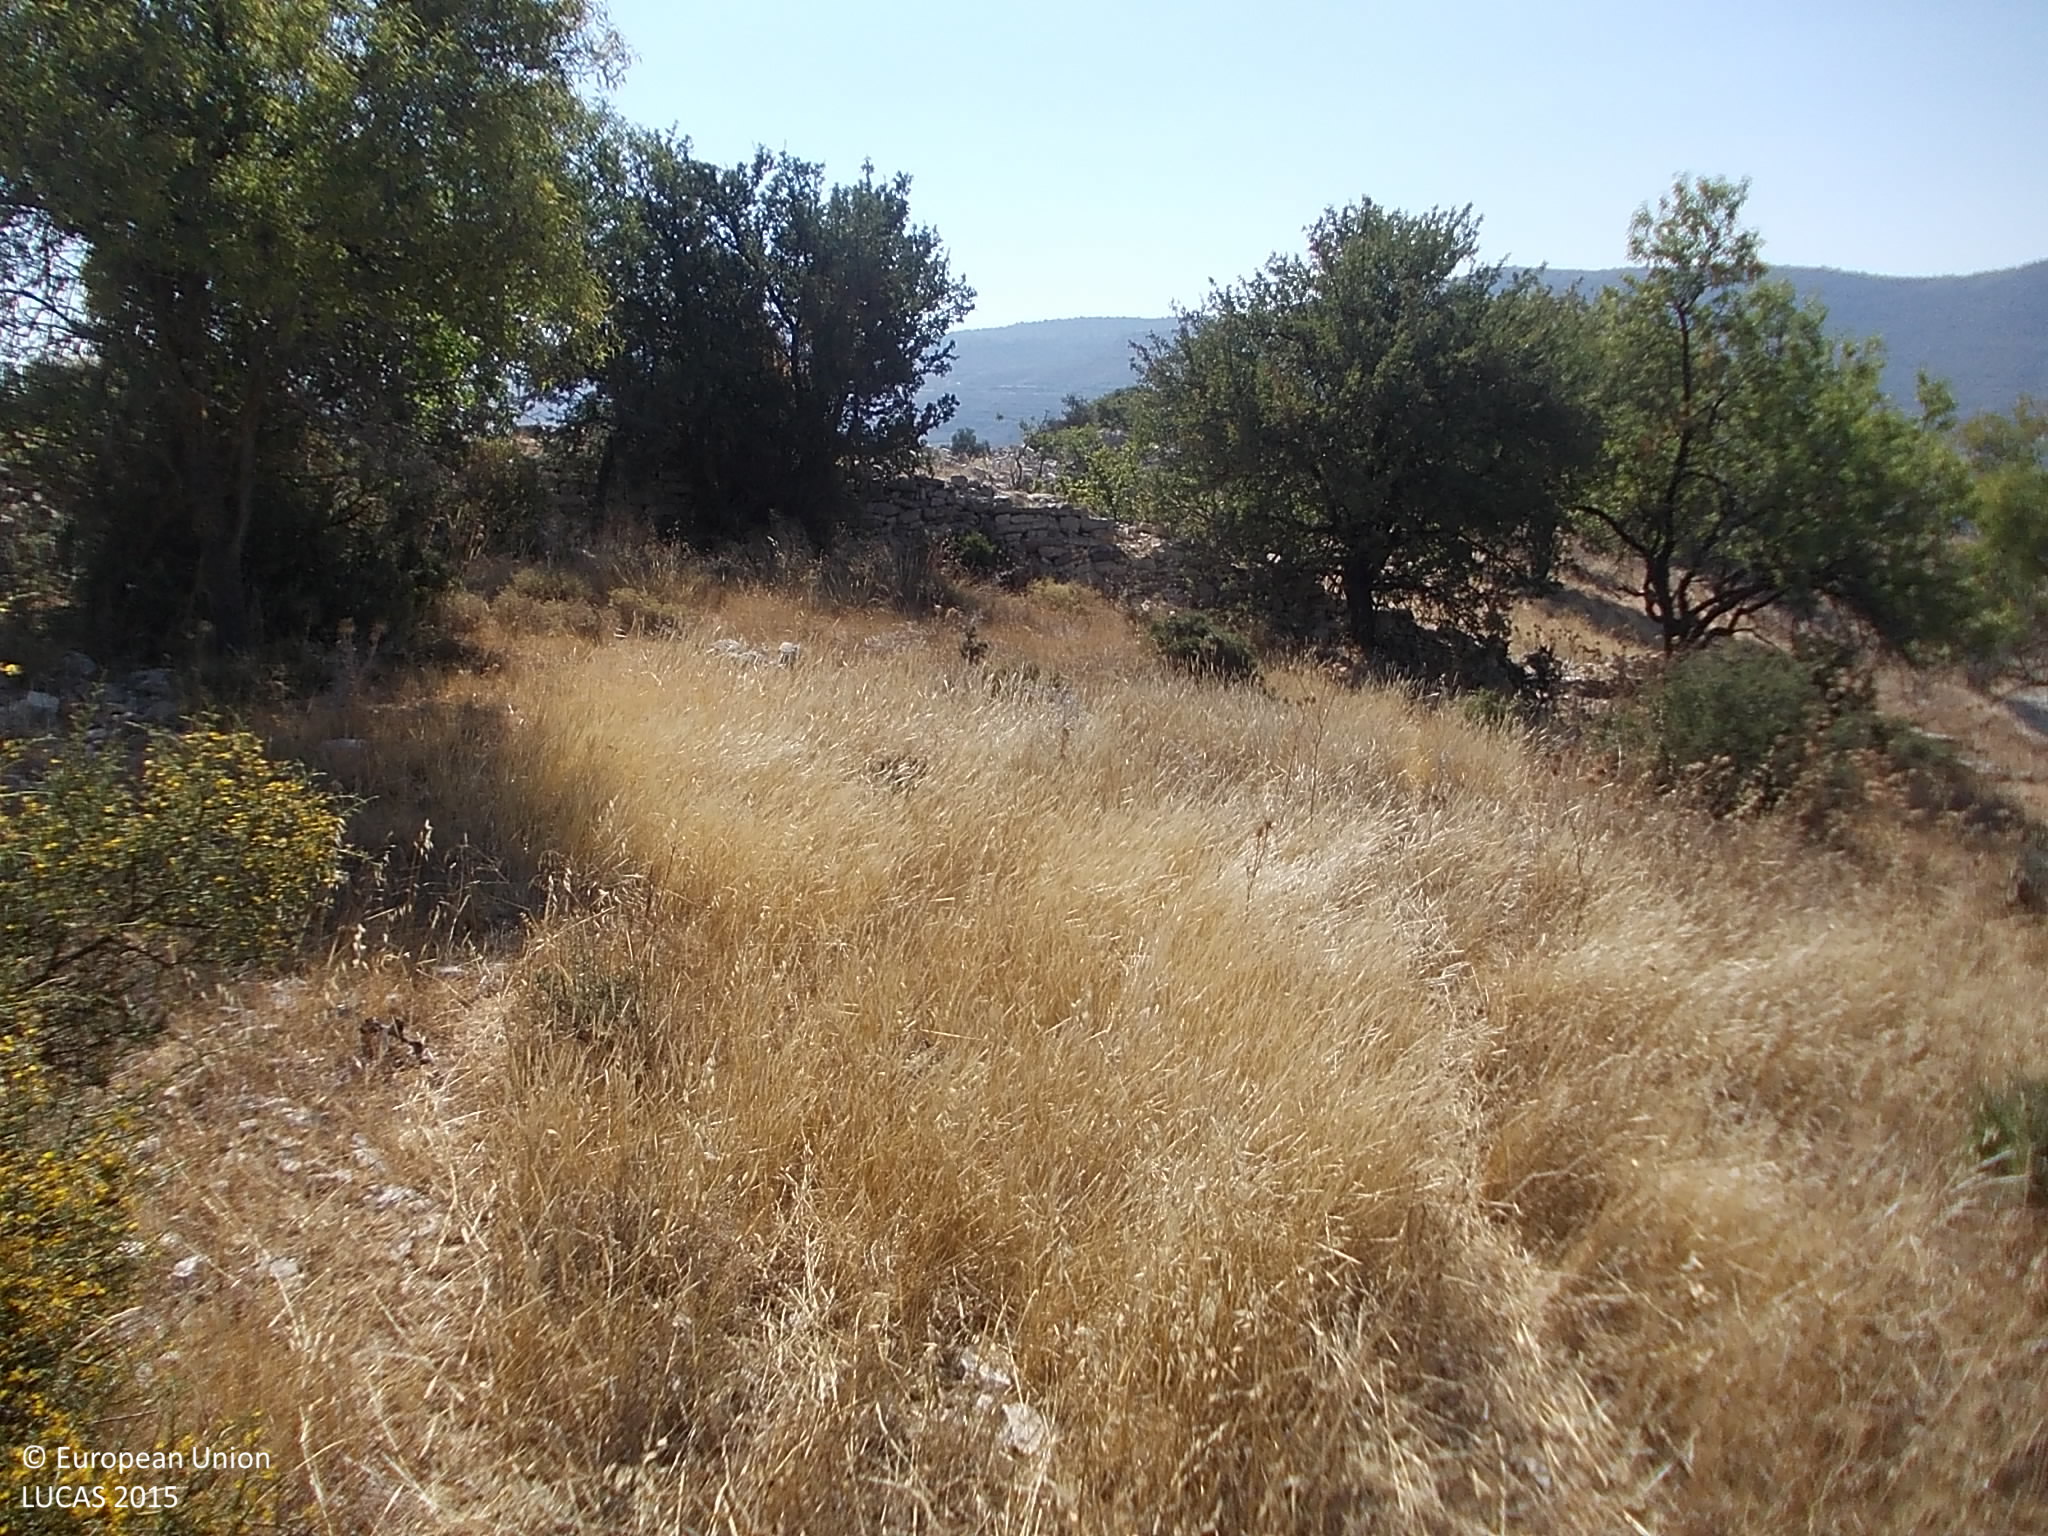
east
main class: Cropland
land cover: Nuts trees
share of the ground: 10 - 25 %
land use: Agriculture (excluding fallow land and kitchen gardens)
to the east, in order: Nuts trees; Dry stone walls; Tracks; Grassland without tree/shrub cover; Tracks; Shrubland with sparse tree cover; Tracks; Broadleaved woodland; Dry stone walls; Broadleaved woodland
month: July
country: CY
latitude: 34.7838
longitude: 32.7452
